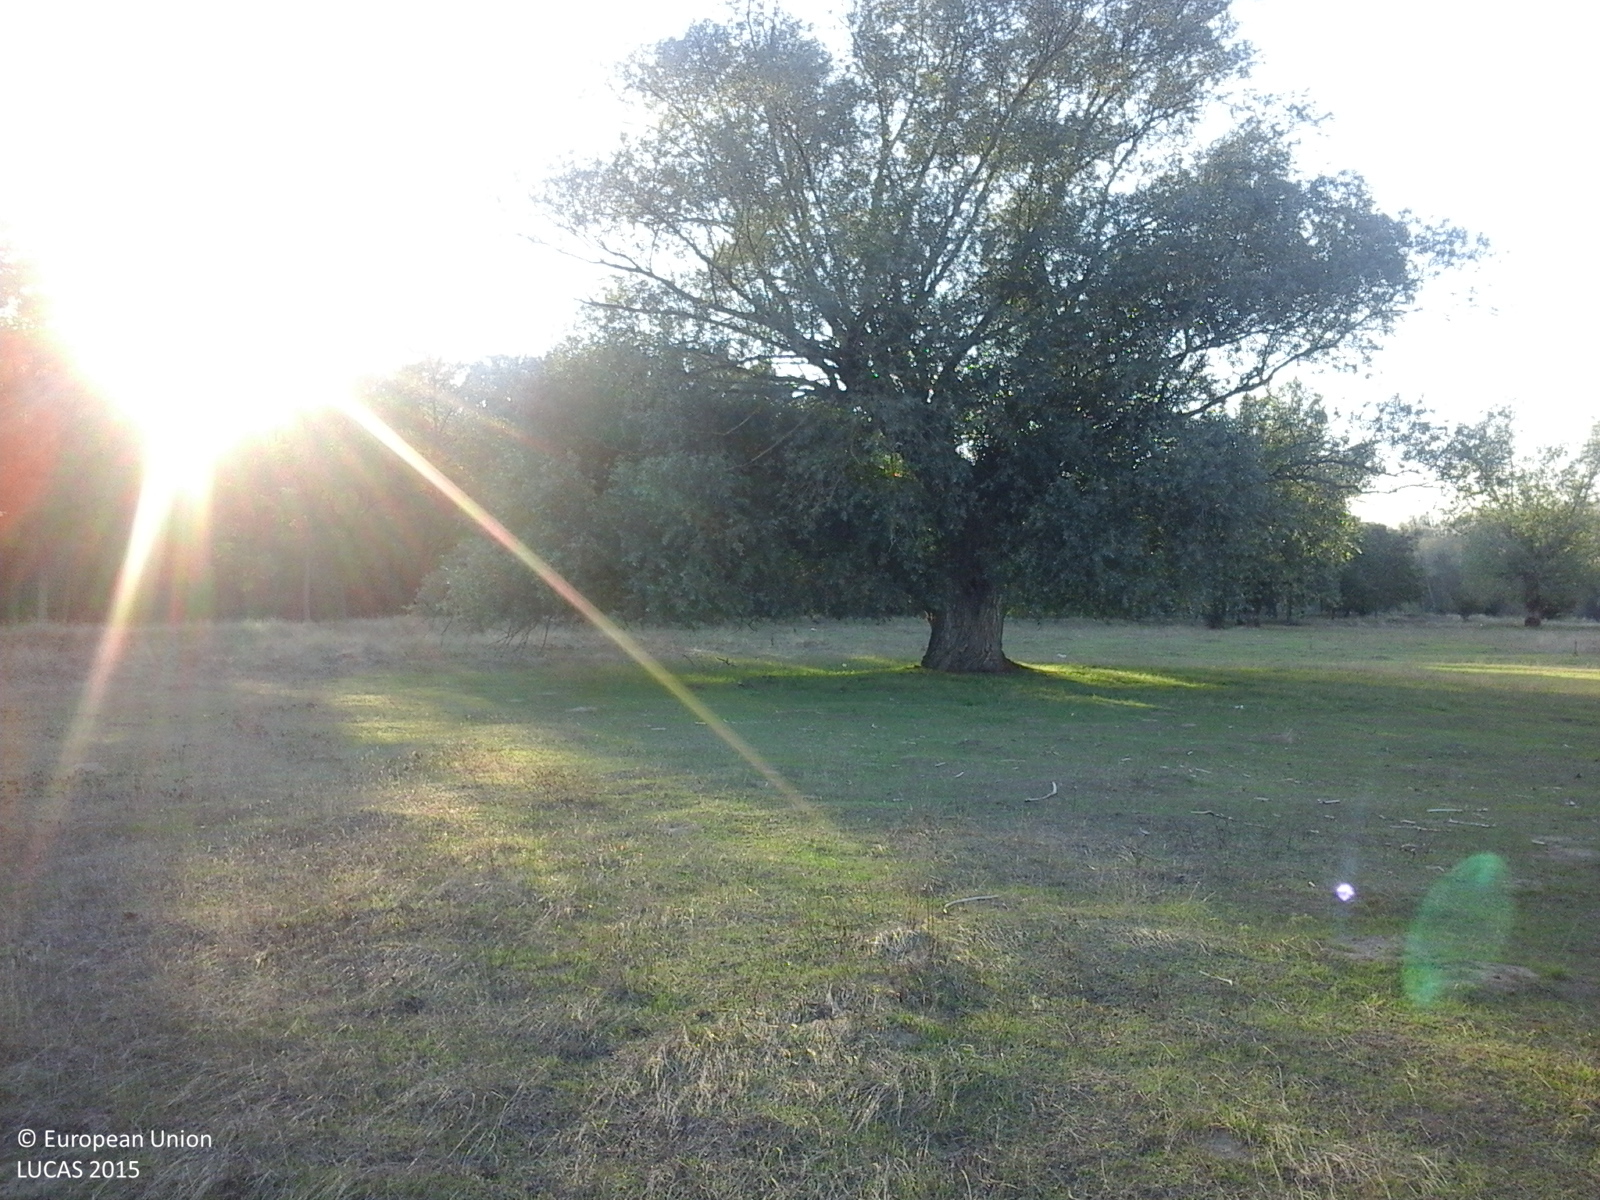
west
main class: Grassland
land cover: Grassland with sparse tree/shrub cover
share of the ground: > 75 %
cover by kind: herbaceous plants 85 %, shrubs 10 %, broadleaved forest trees 5 %
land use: Agriculture (excluding fallow land and kitchen gardens)
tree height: < 5 m
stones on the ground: < 10 %
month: August
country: RO
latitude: 46.1422
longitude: 21.2045
